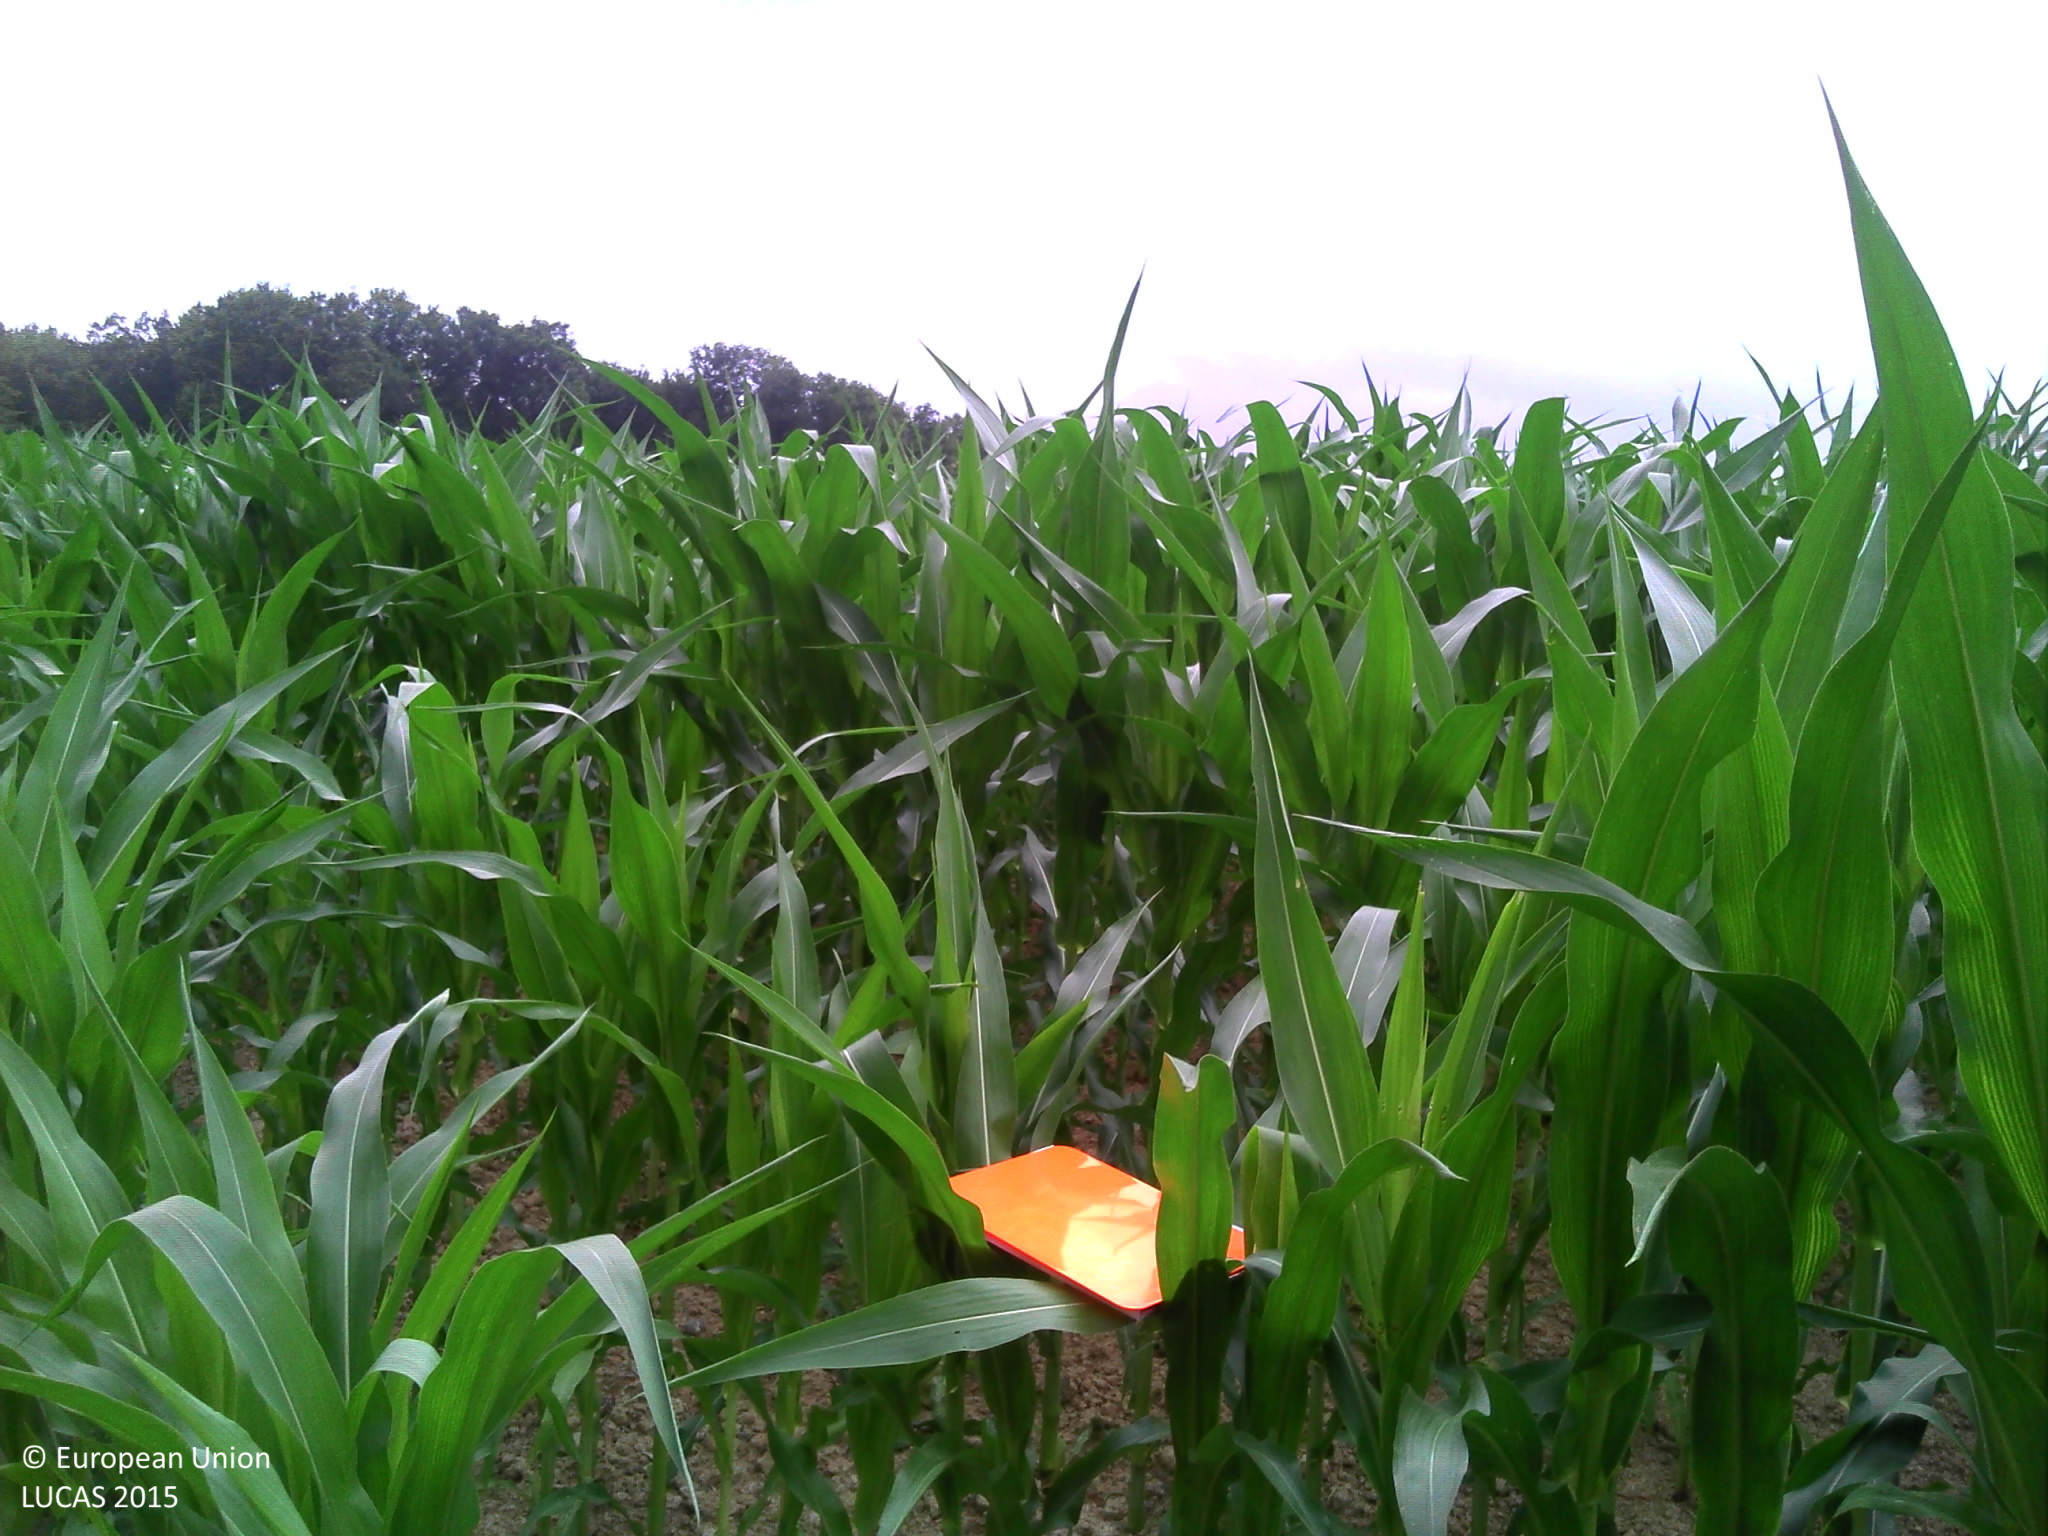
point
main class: Cropland
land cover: Maize
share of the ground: 50 - 75 %
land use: Agriculture (excluding fallow land and kitchen gardens)
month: July
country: FR
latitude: 43.5751
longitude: -0.7228
